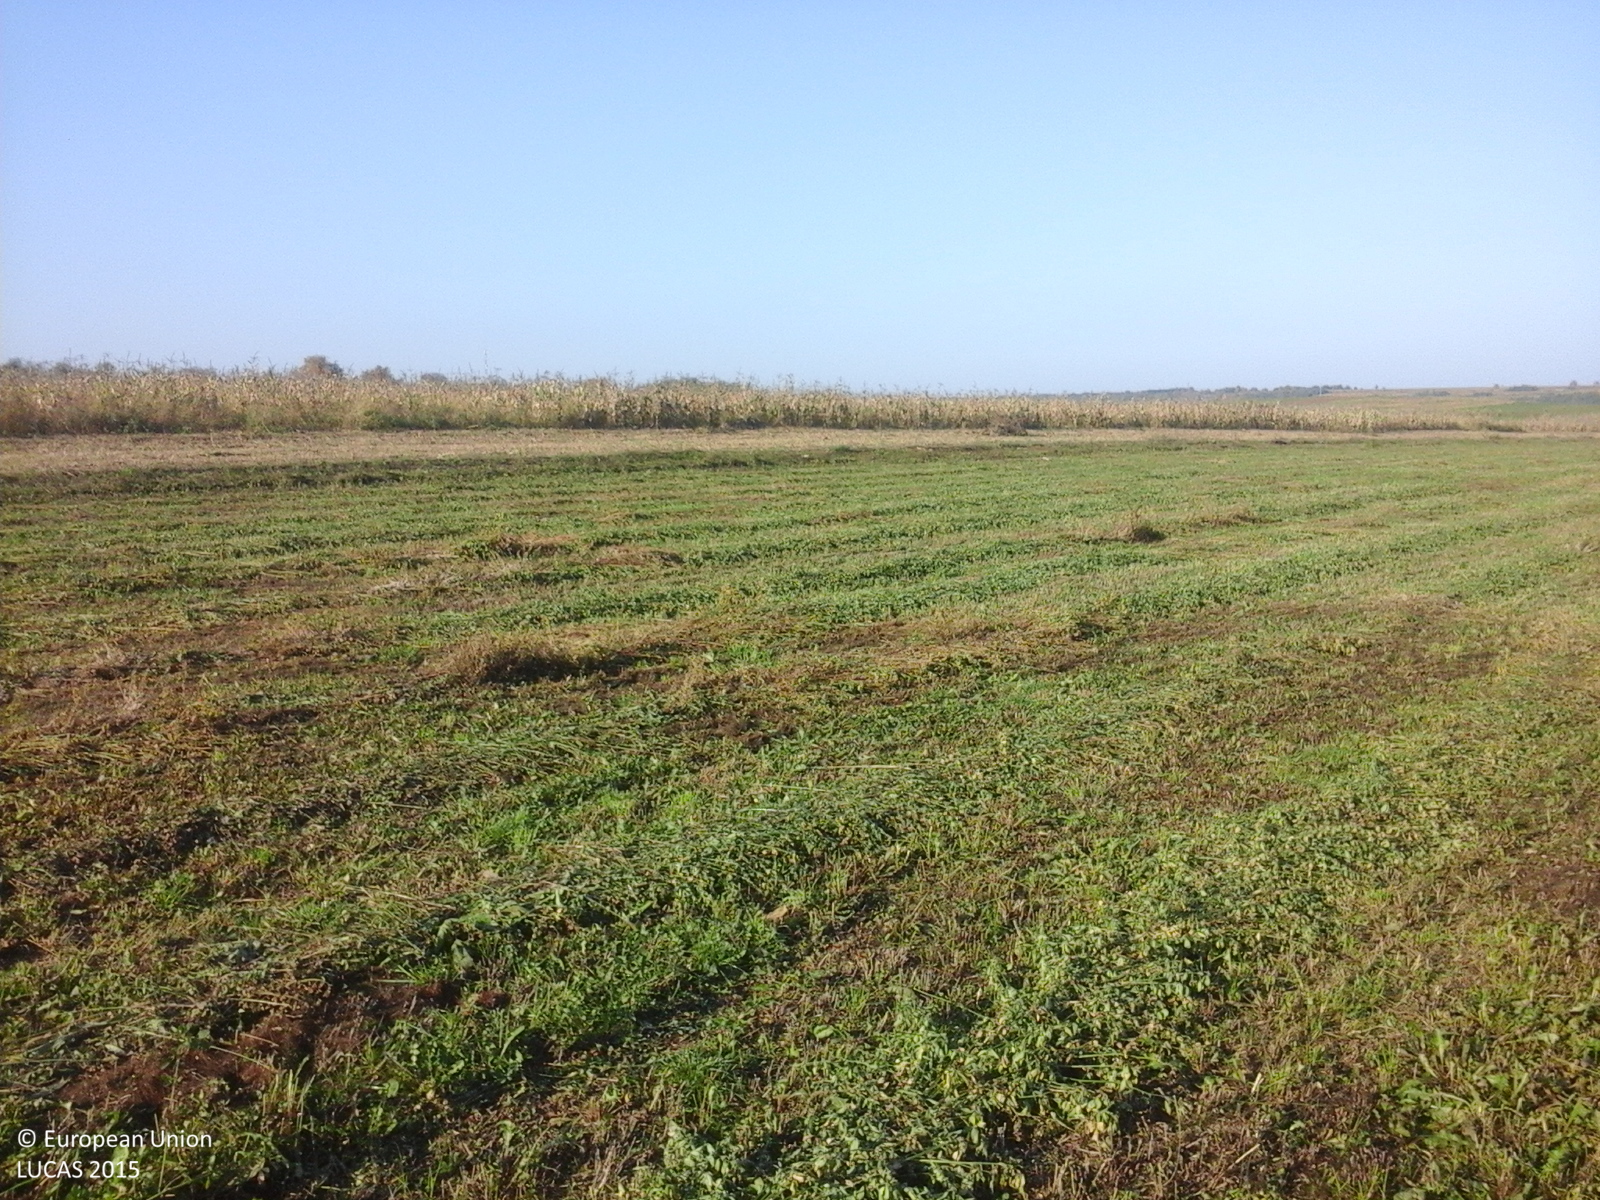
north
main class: Cropland
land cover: Lucerne
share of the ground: > 75 %
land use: Agriculture (excluding fallow land and kitchen gardens)
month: October
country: RO
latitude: 45.9607
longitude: 27.0613
